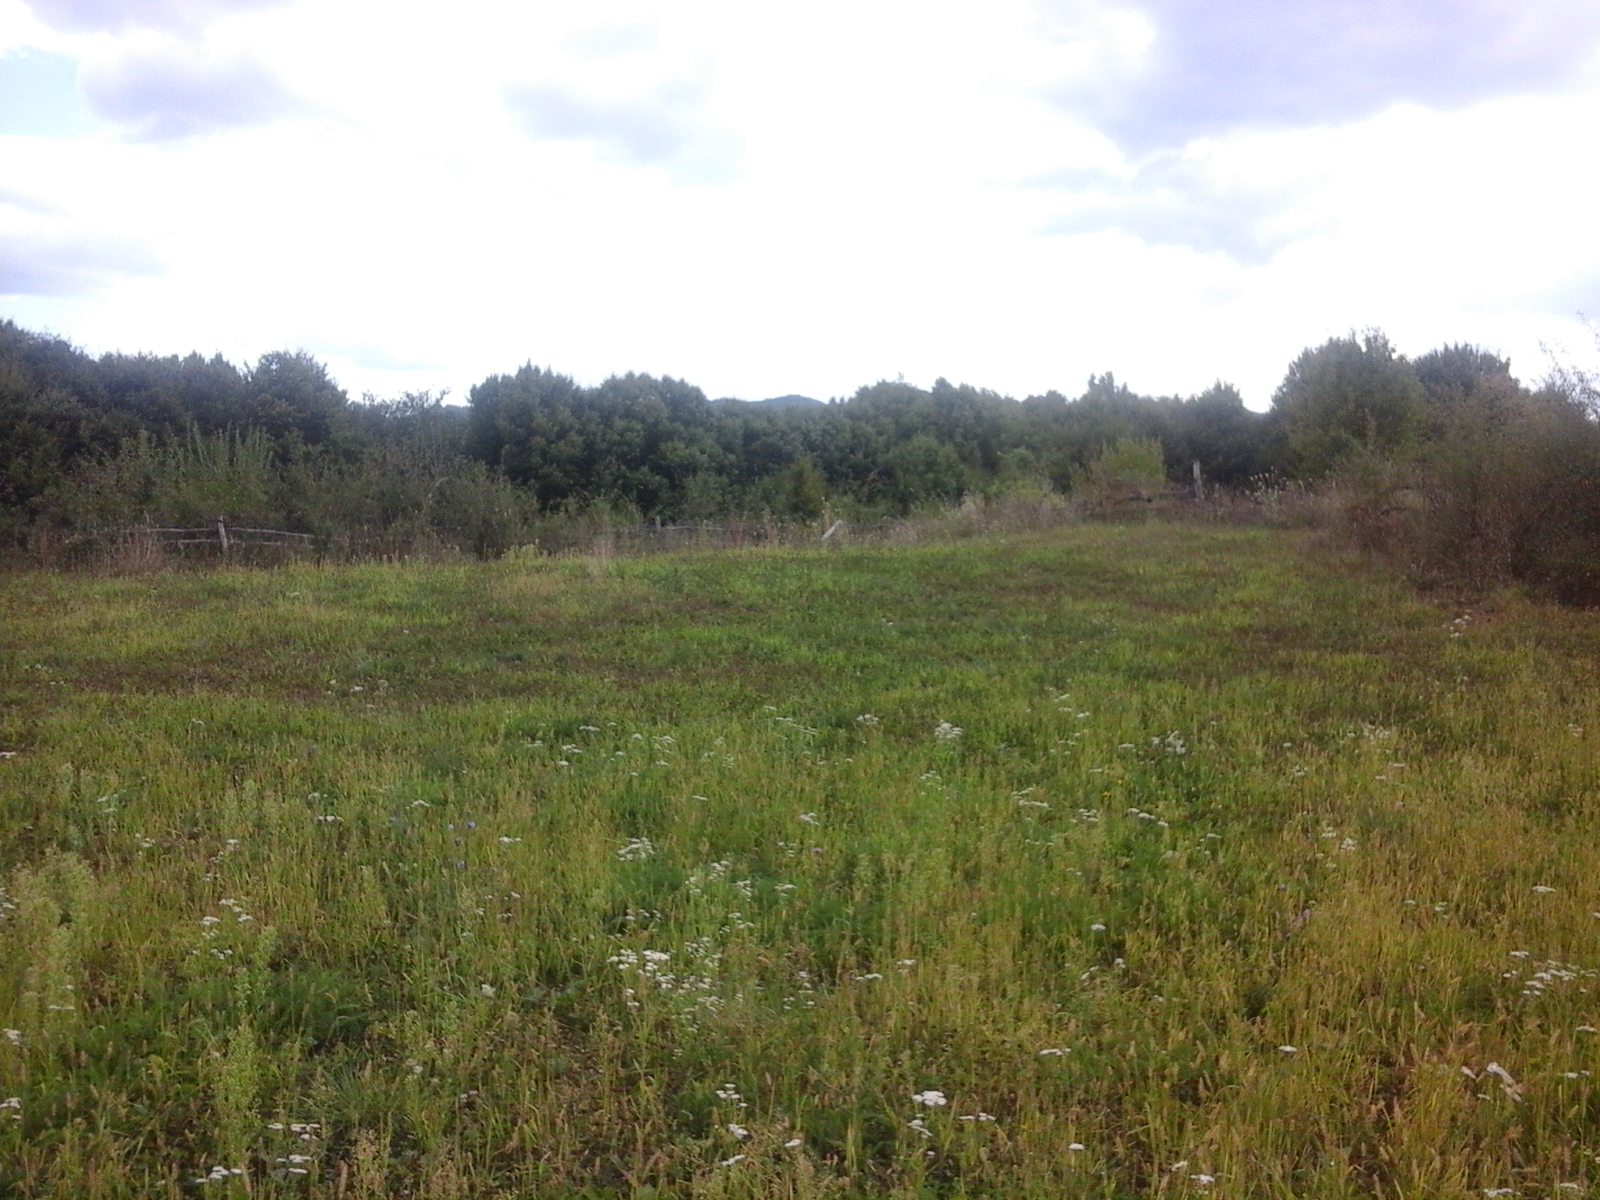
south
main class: Grassland
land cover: Grassland without tree/shrub cover
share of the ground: > 75 %
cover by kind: herbaceous plants 100 %
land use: Agriculture (excluding fallow land and kitchen gardens)
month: September
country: RO
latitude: 47.4303
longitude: 23.7466
